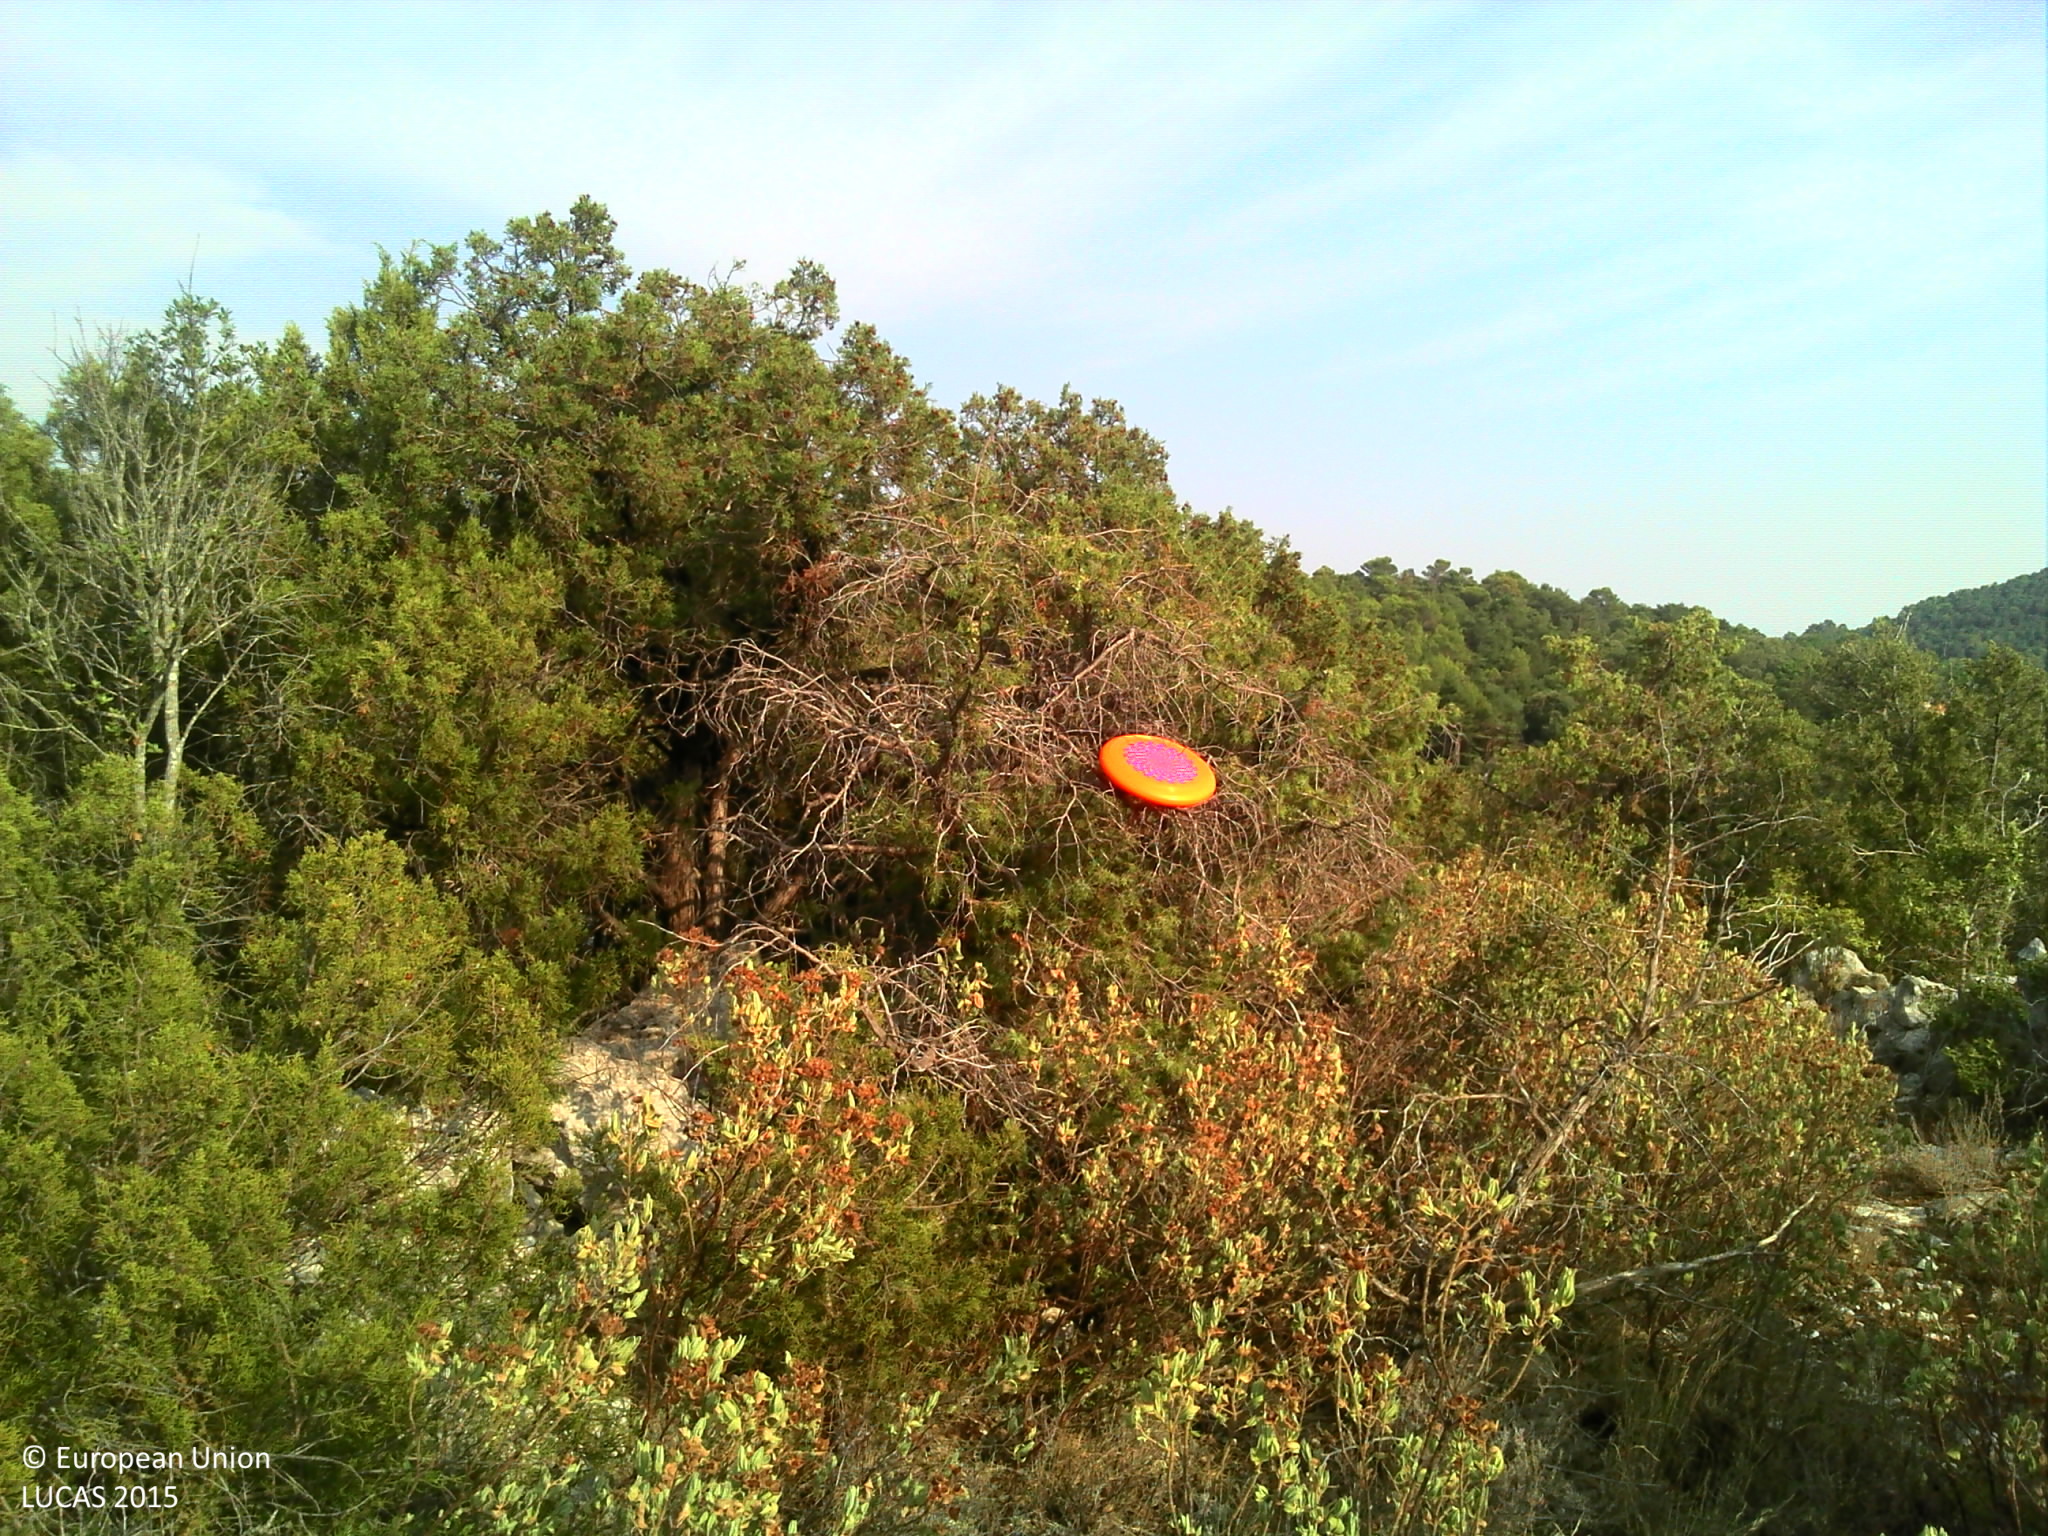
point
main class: Shrubland
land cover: Shrubland without tree cover
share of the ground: > 75 %
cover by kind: shrubs 70 %, unconsolidated bare surface 30 %
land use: Semi-natural and natural areas not in use
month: August
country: FR
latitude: 43.6012
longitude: 6.3787
